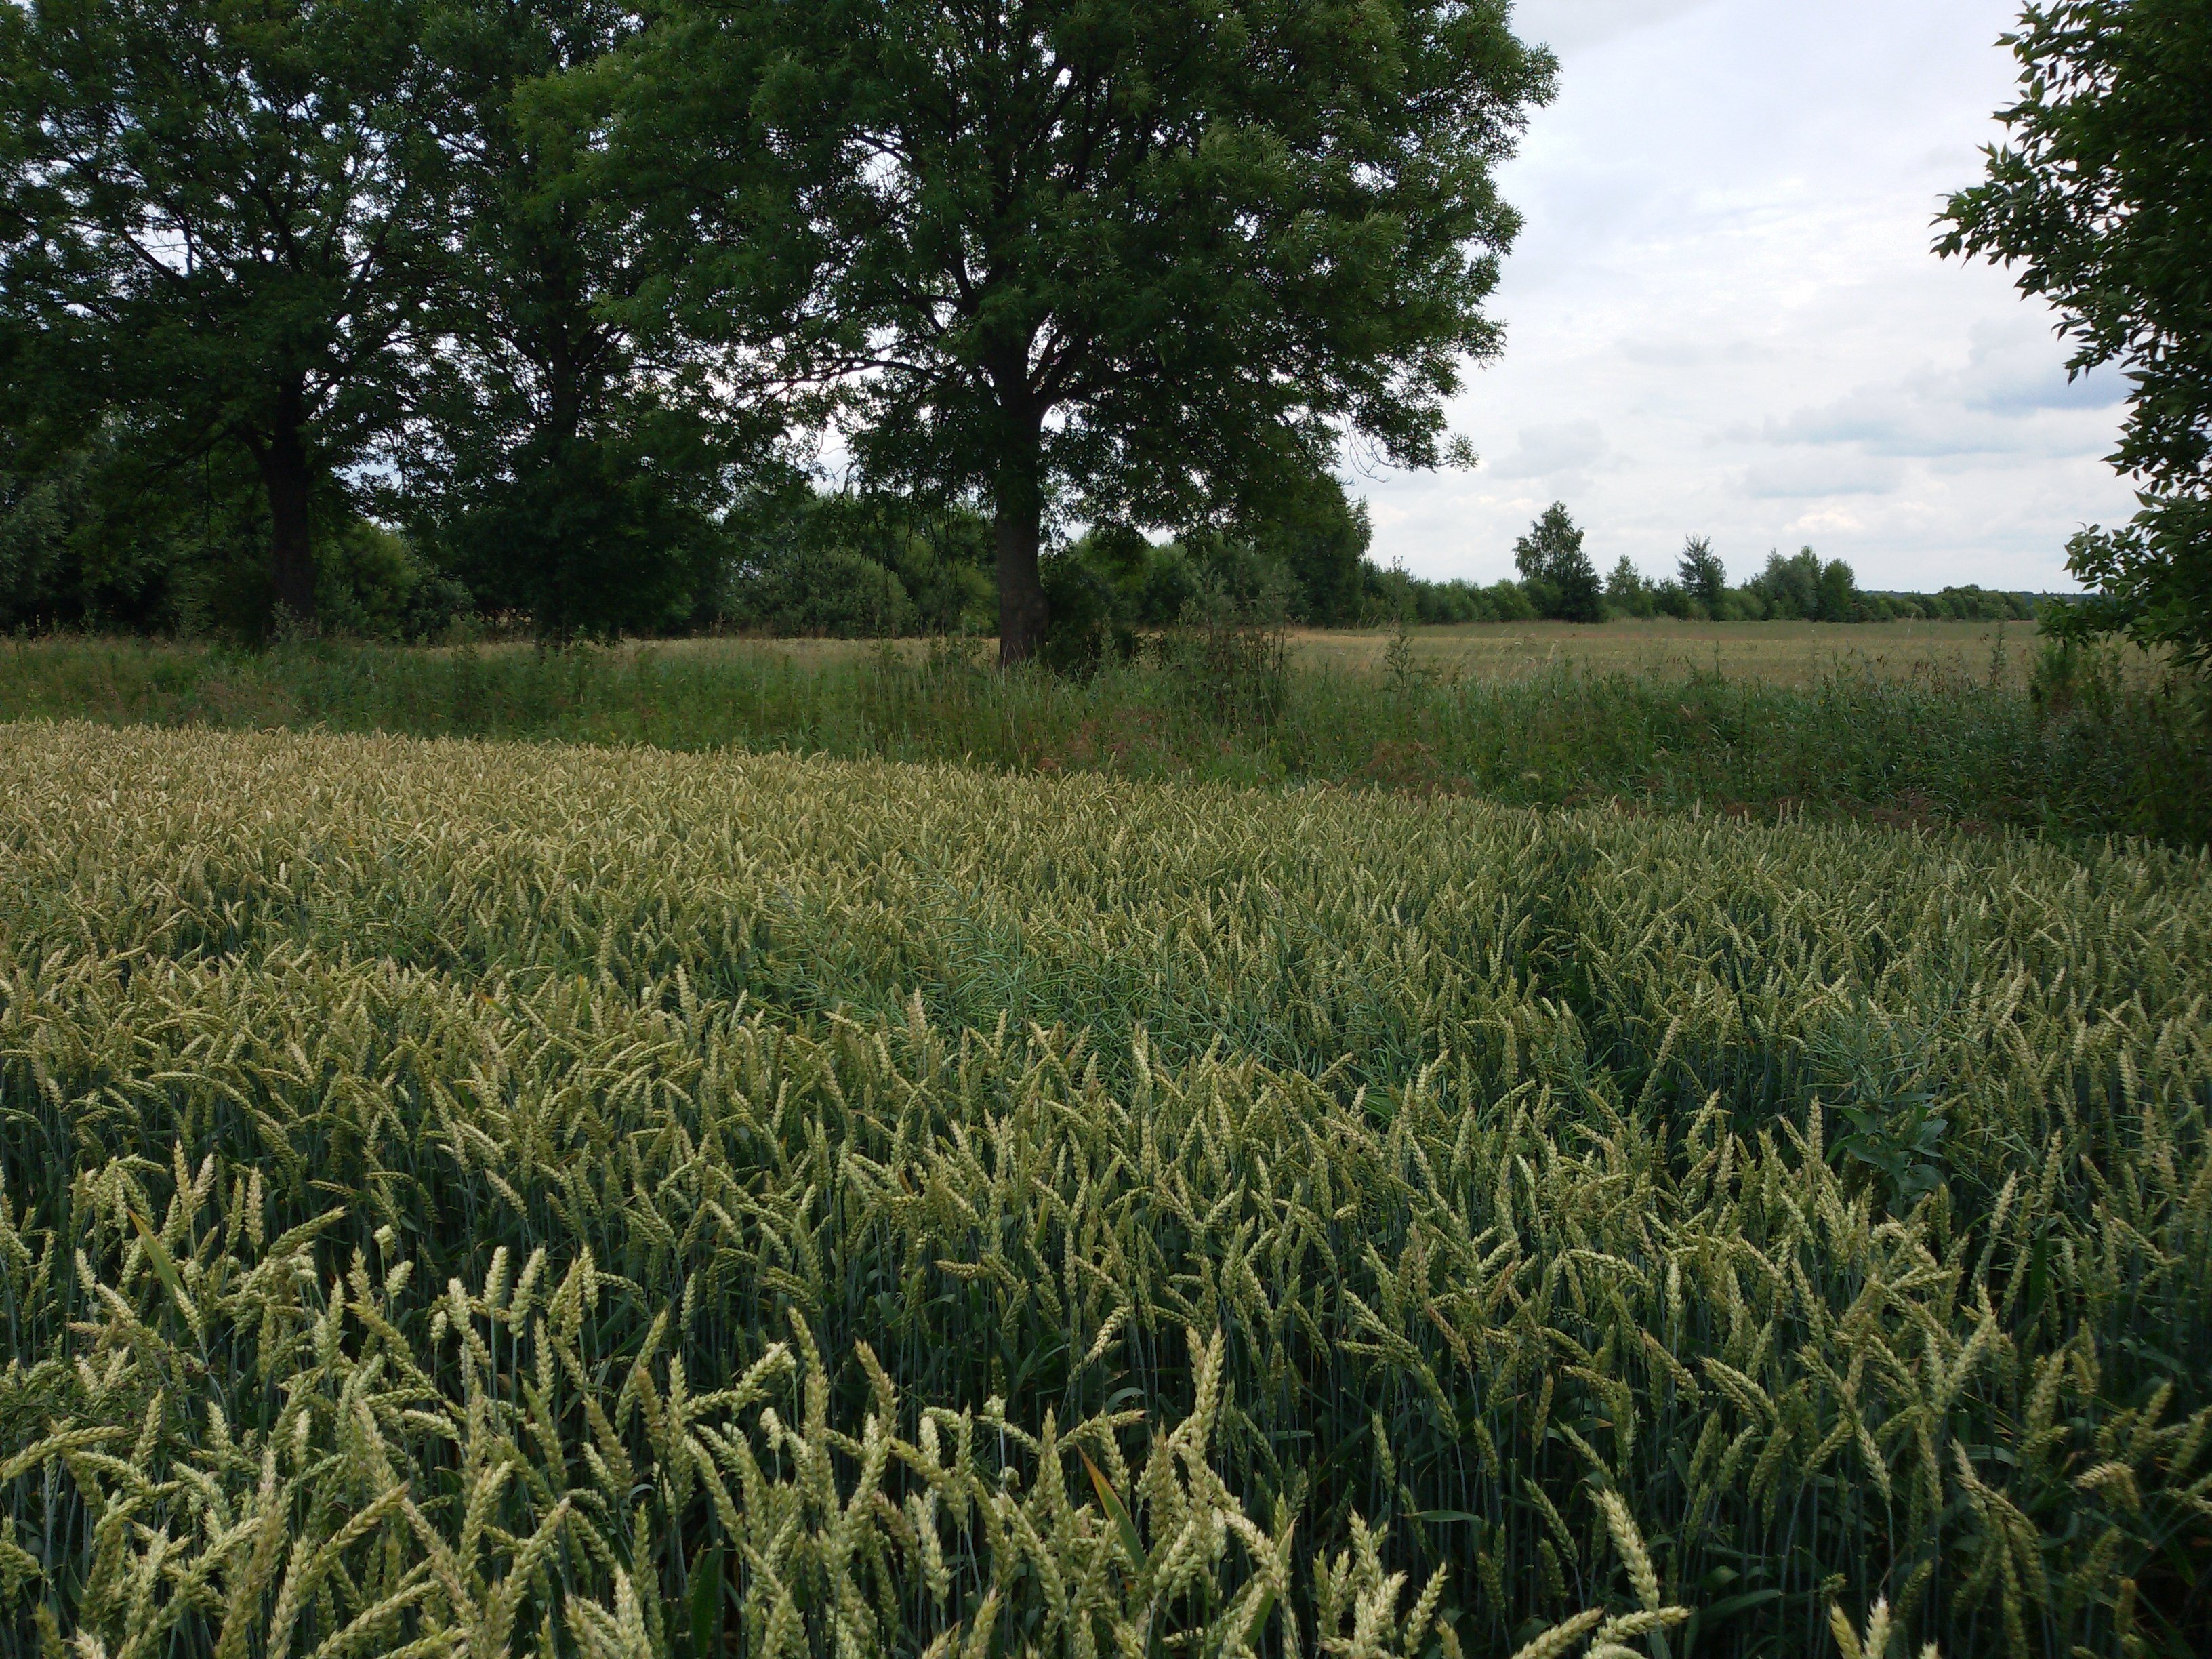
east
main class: Cropland
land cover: Common wheat
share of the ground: > 75 %
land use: Agriculture (excluding fallow land and kitchen gardens)
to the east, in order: Common wheat; Lines of trees; Paved roads, cycling and walking lanes; Lines of trees; Common wheat; Oats; Tracks; Broadleaved woodland; Common wheat; Rape and turnip rape
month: July
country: PL
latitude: 51.7292
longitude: 22.8570
